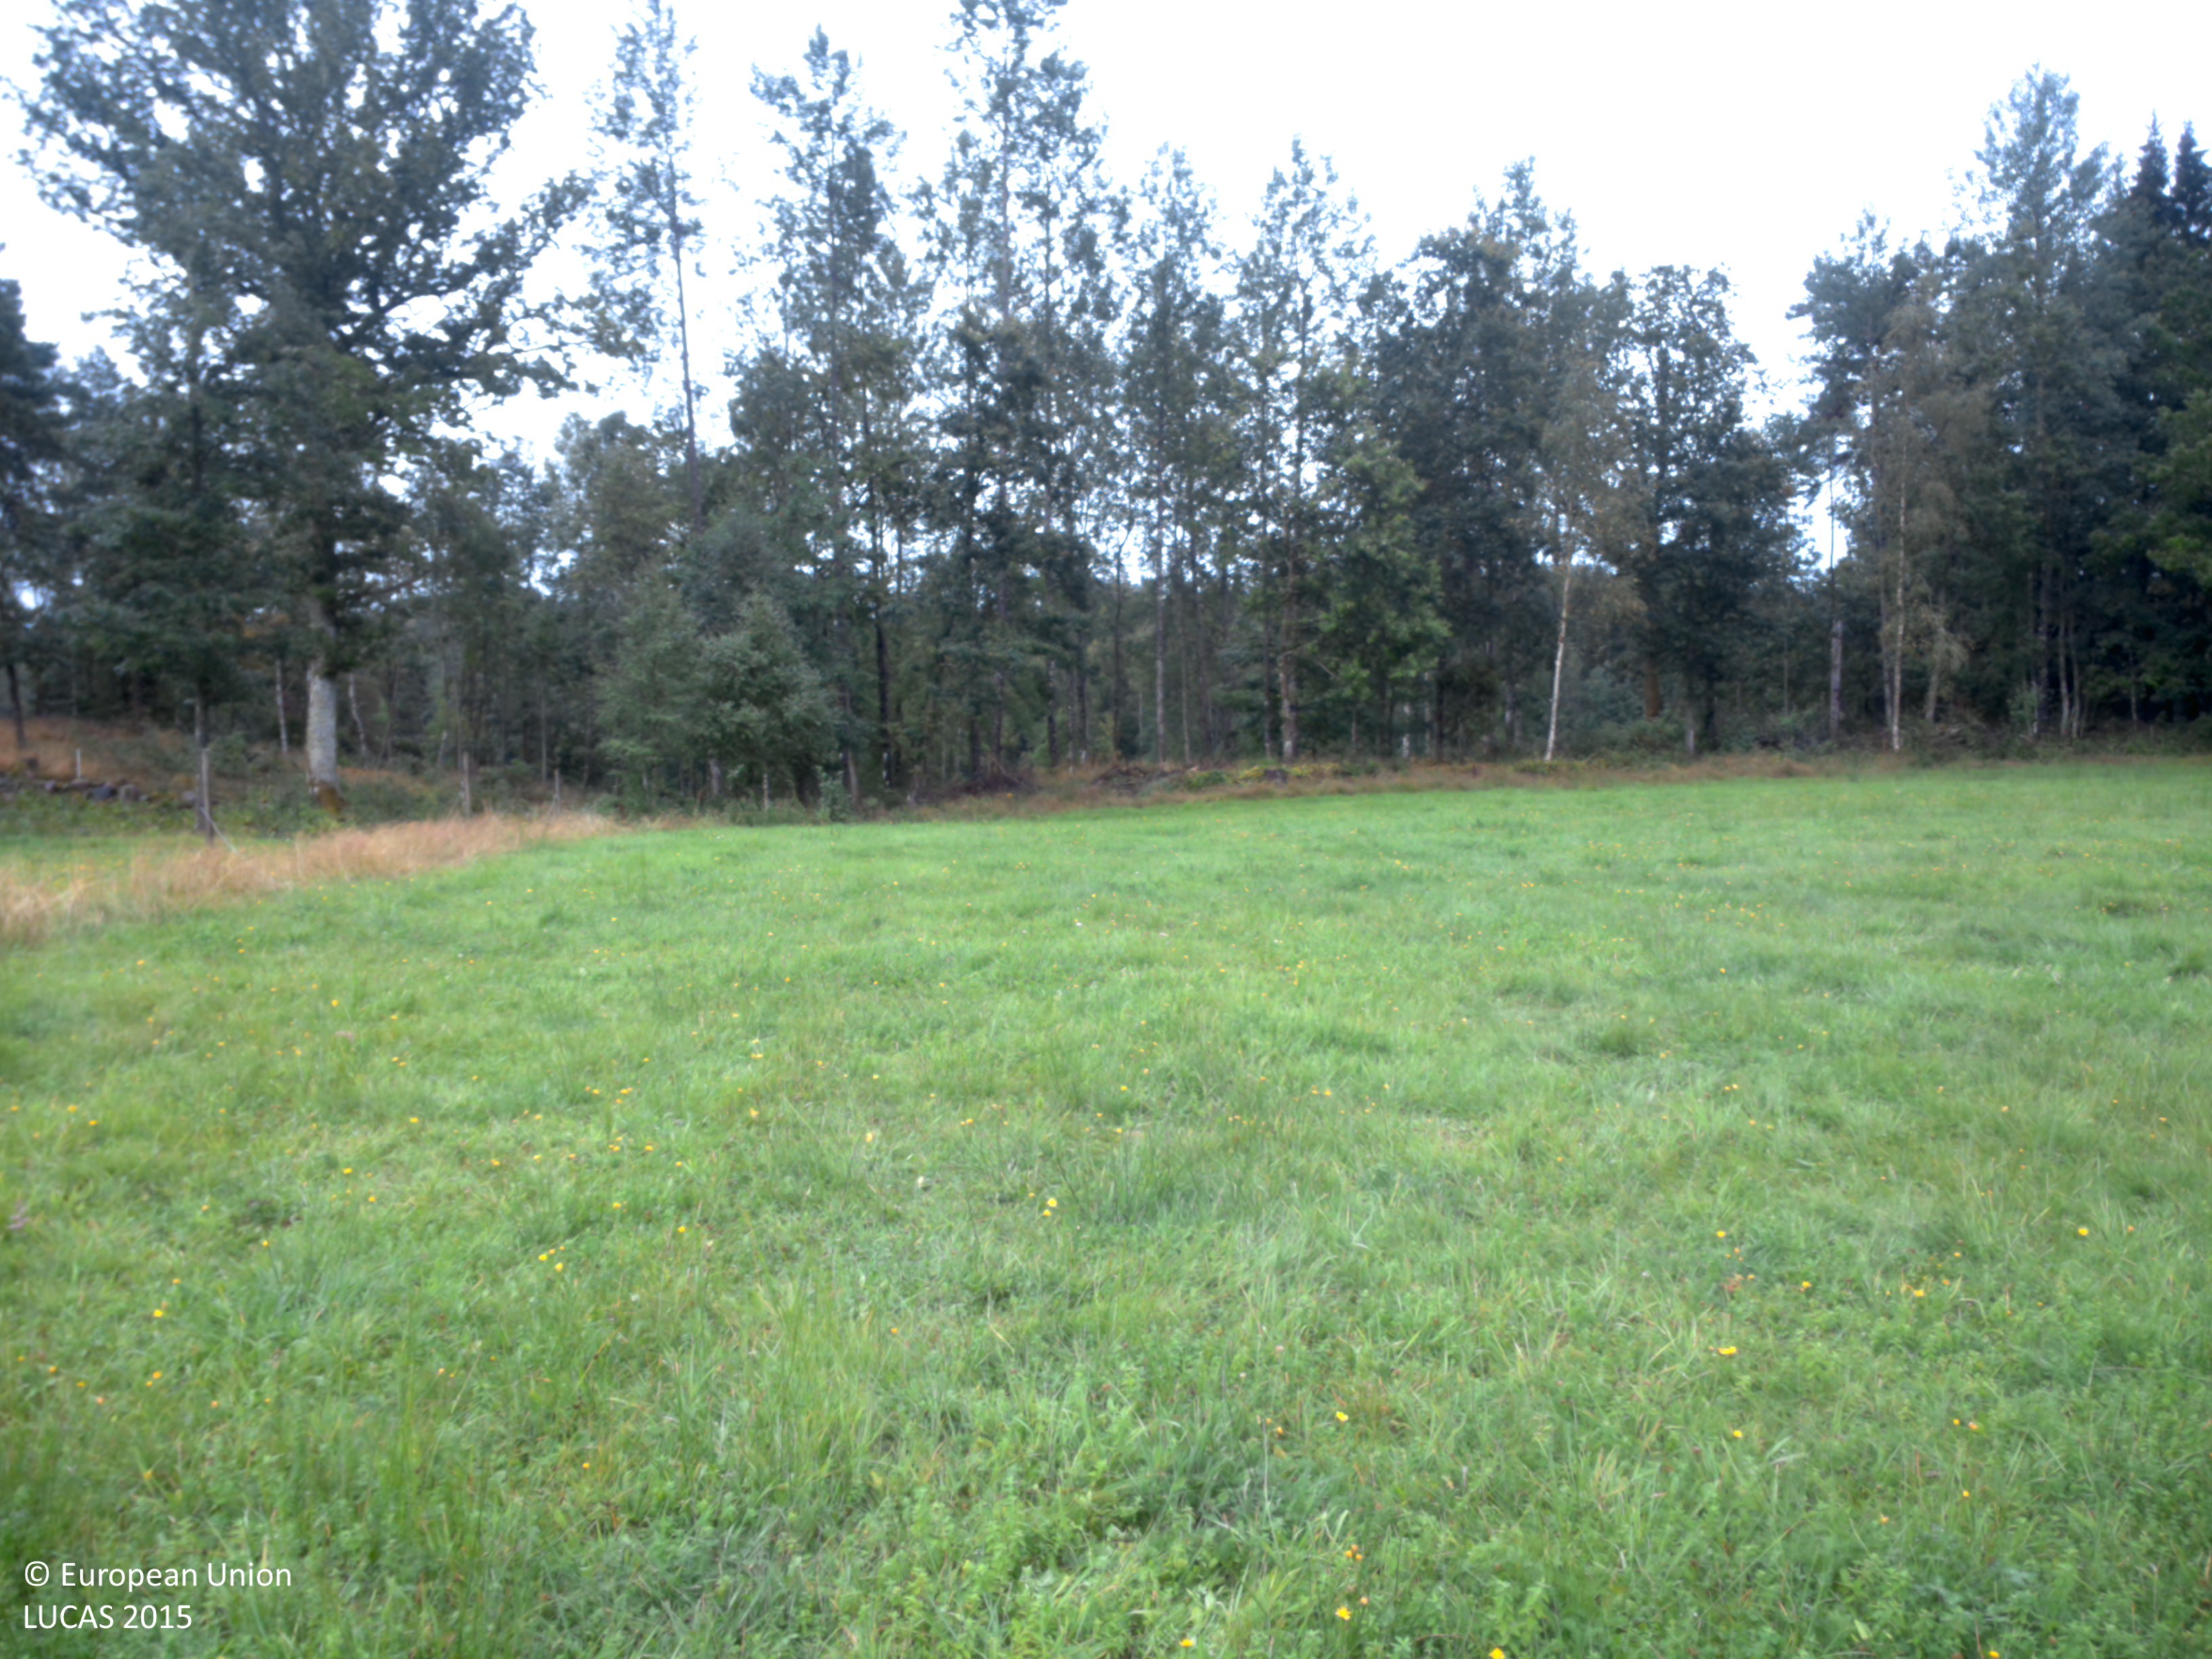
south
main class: Grassland
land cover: Grassland without tree/shrub cover
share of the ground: > 75 %
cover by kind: herbaceous plants 100 %
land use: Agriculture (excluding fallow land and kitchen gardens)
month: August
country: SE
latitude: 58.1095
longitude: 12.3208
